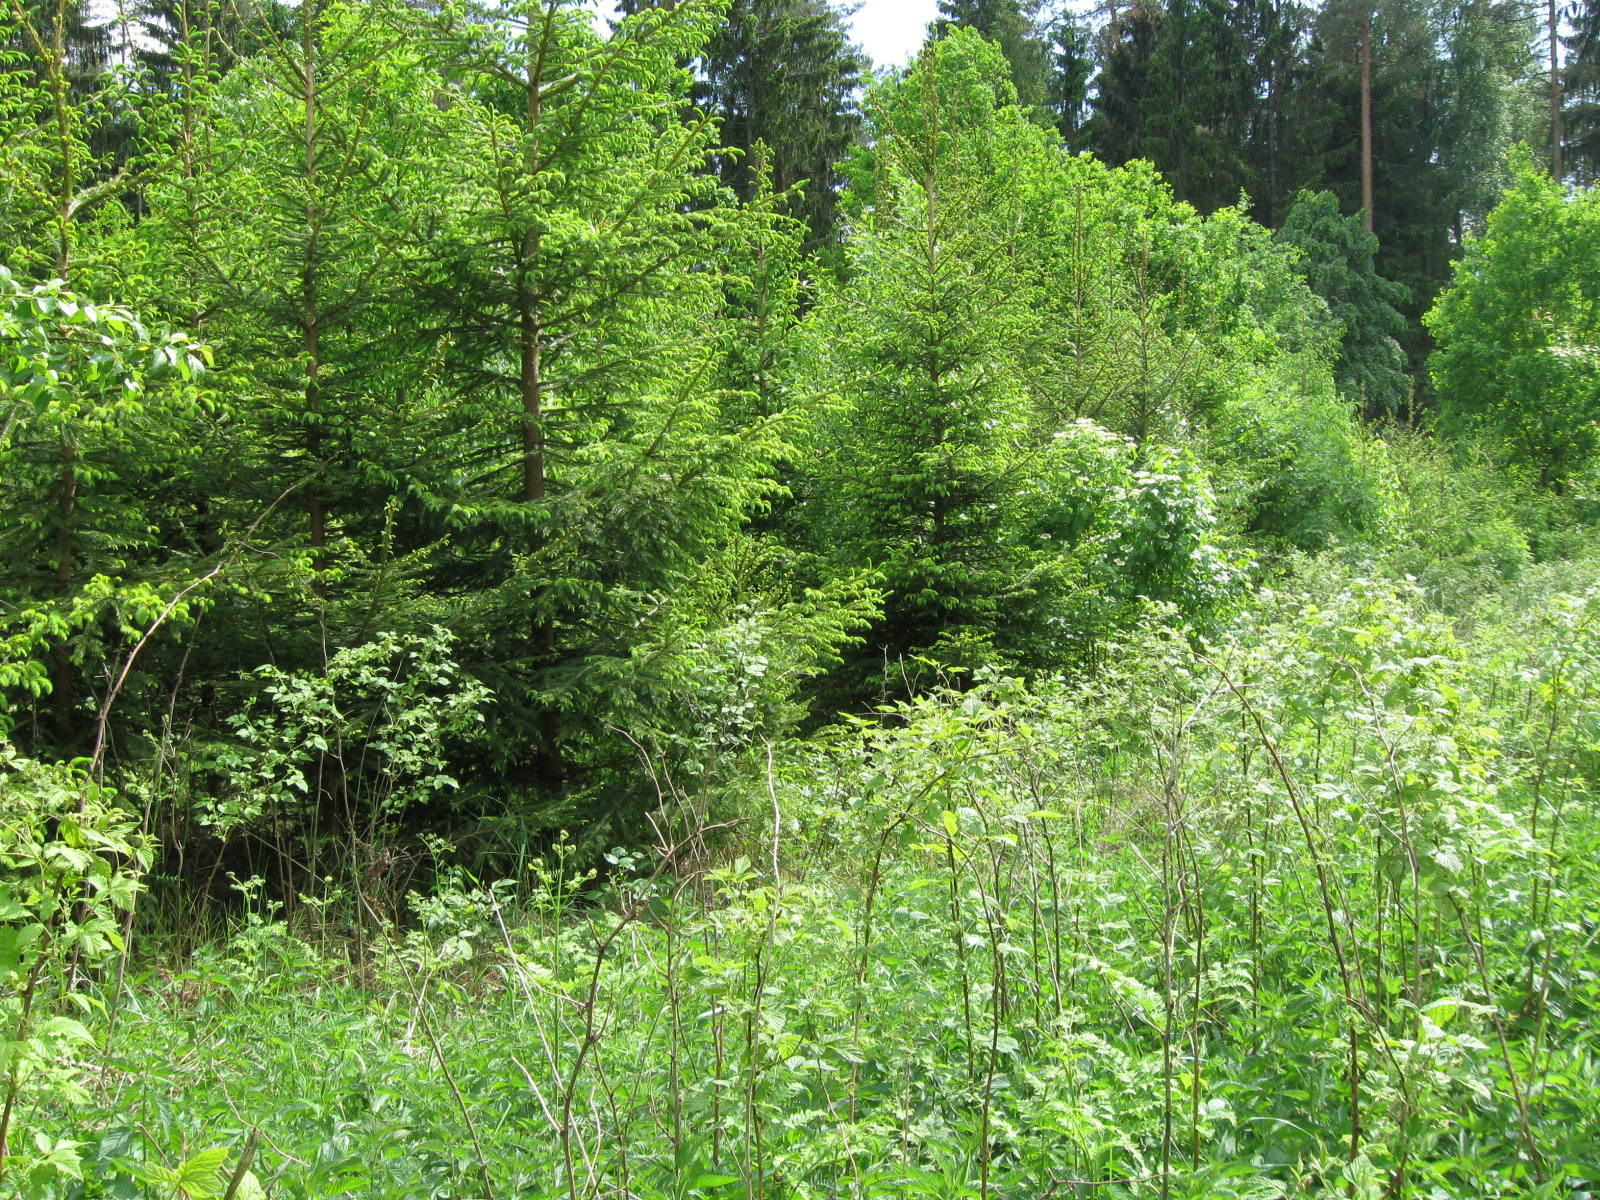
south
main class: Woodland
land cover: Spruce dominated mixed woodland
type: hemiboreal forest and nemoral coniferous forest and mixed broadleaved-coniferous forest
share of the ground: > 75 %
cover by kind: coniferous forest trees 30 %, broadleaved forest trees 30 %, herbaceous plants 30 %, shrubs 10 %
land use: Forestry
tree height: < 5 m
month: June
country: LT
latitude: 54.6410
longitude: 23.8954
